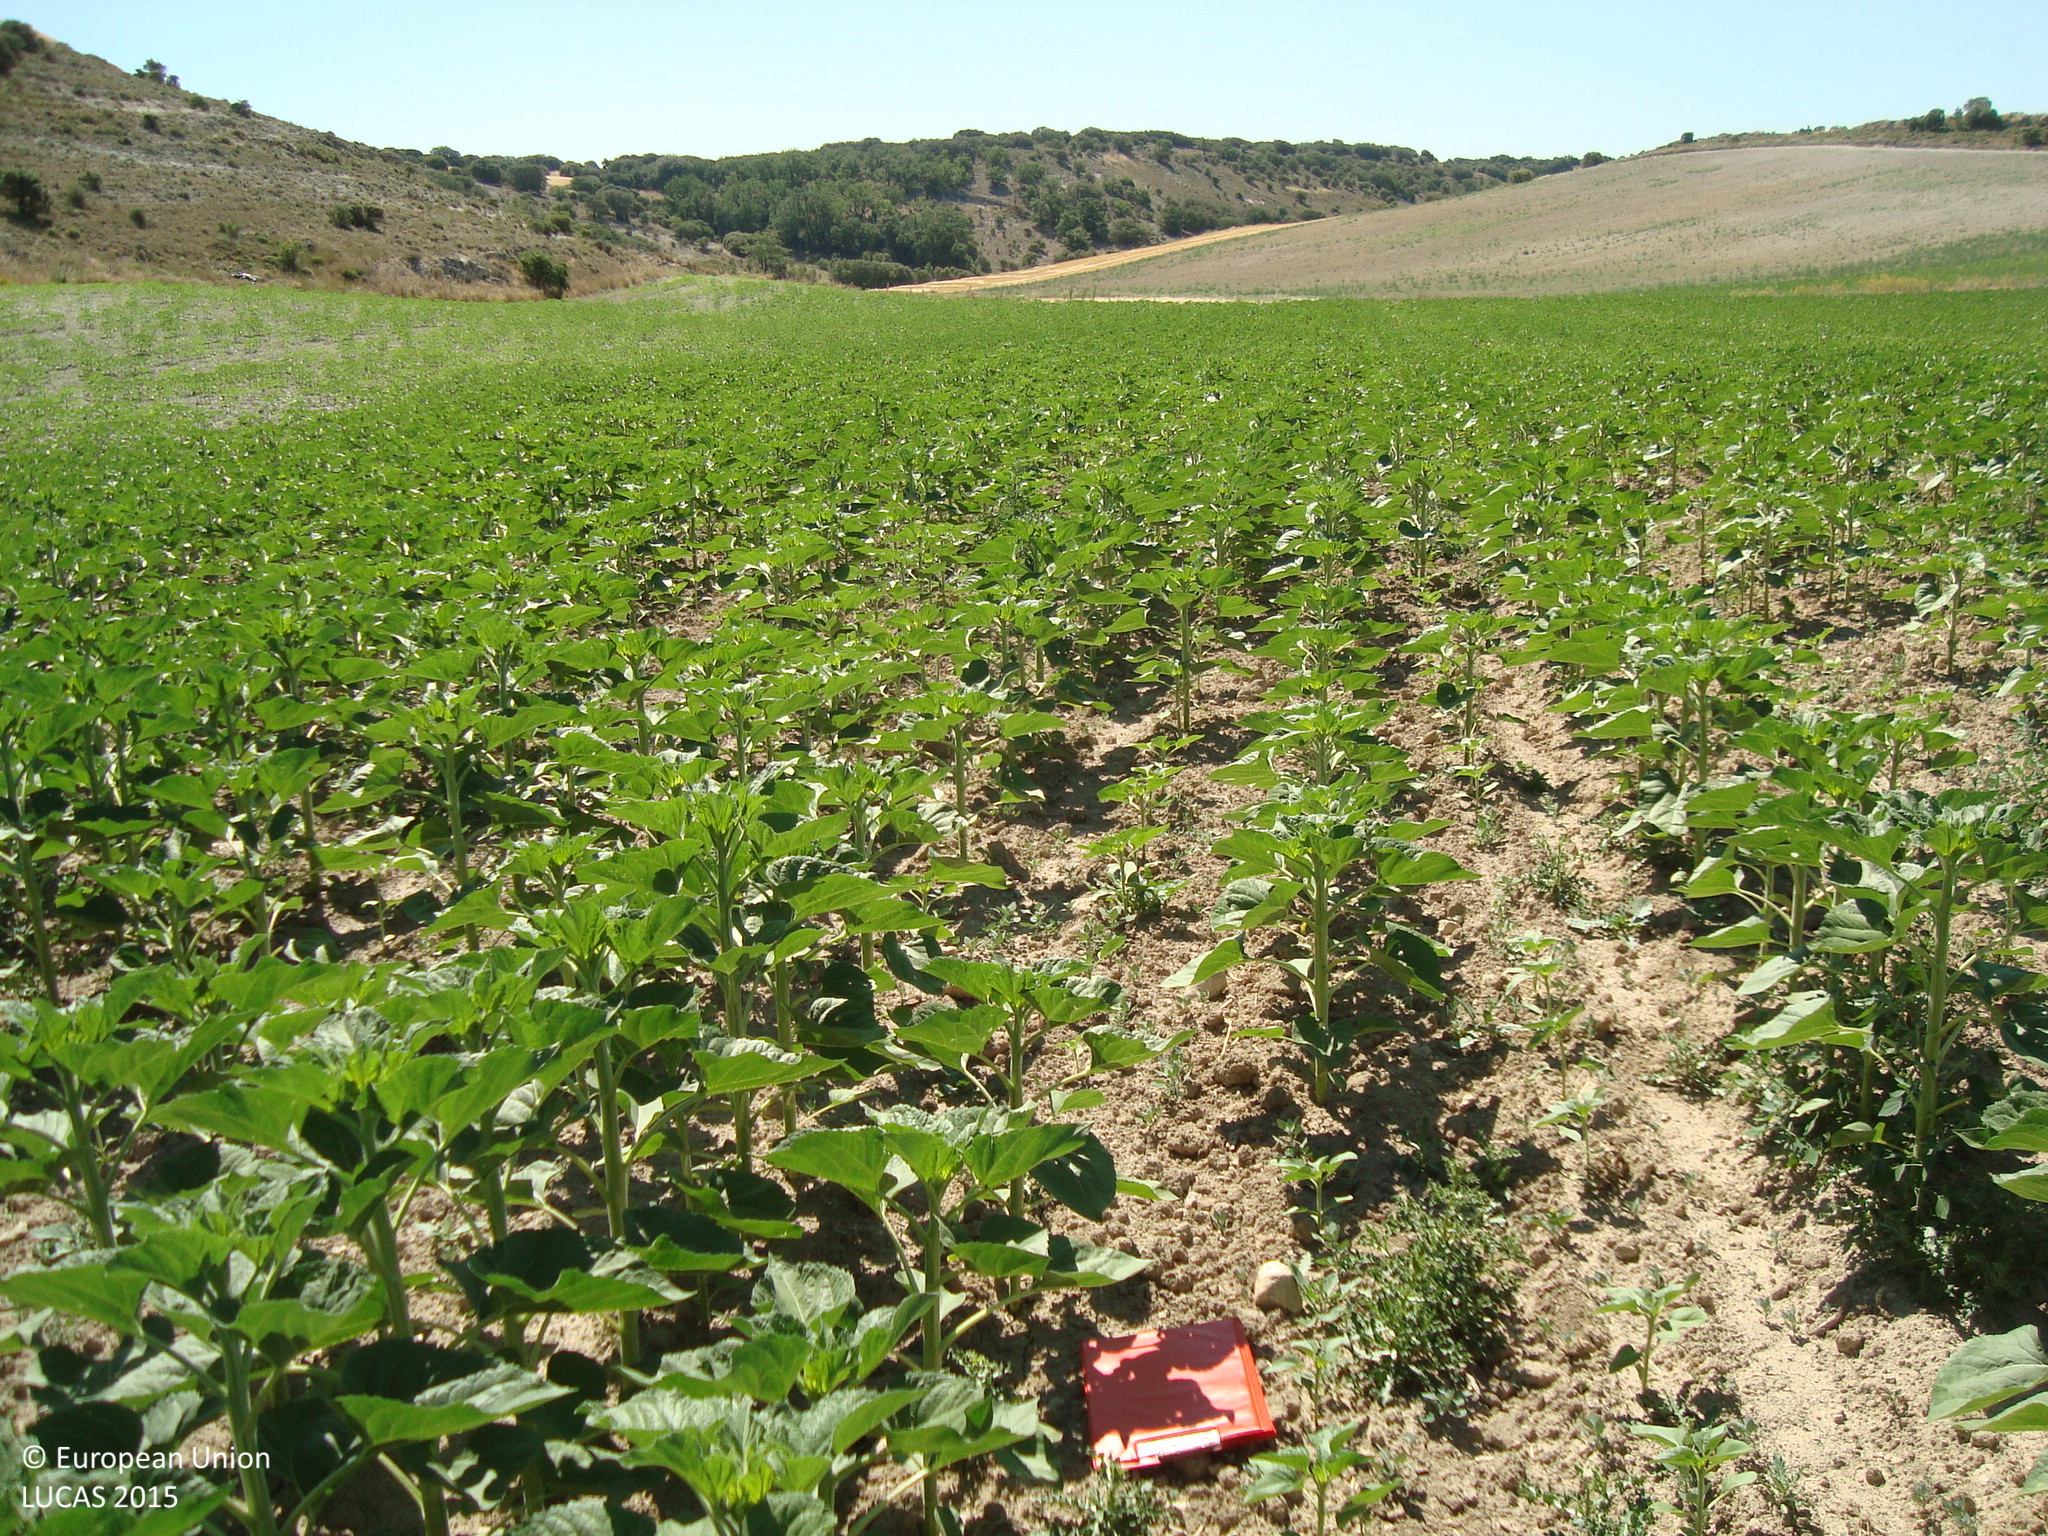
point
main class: Cropland
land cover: Sunflower
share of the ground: 50 - 75 %
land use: Agriculture (excluding fallow land and kitchen gardens)
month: July
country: ES
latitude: 41.6657
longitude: -4.0744
